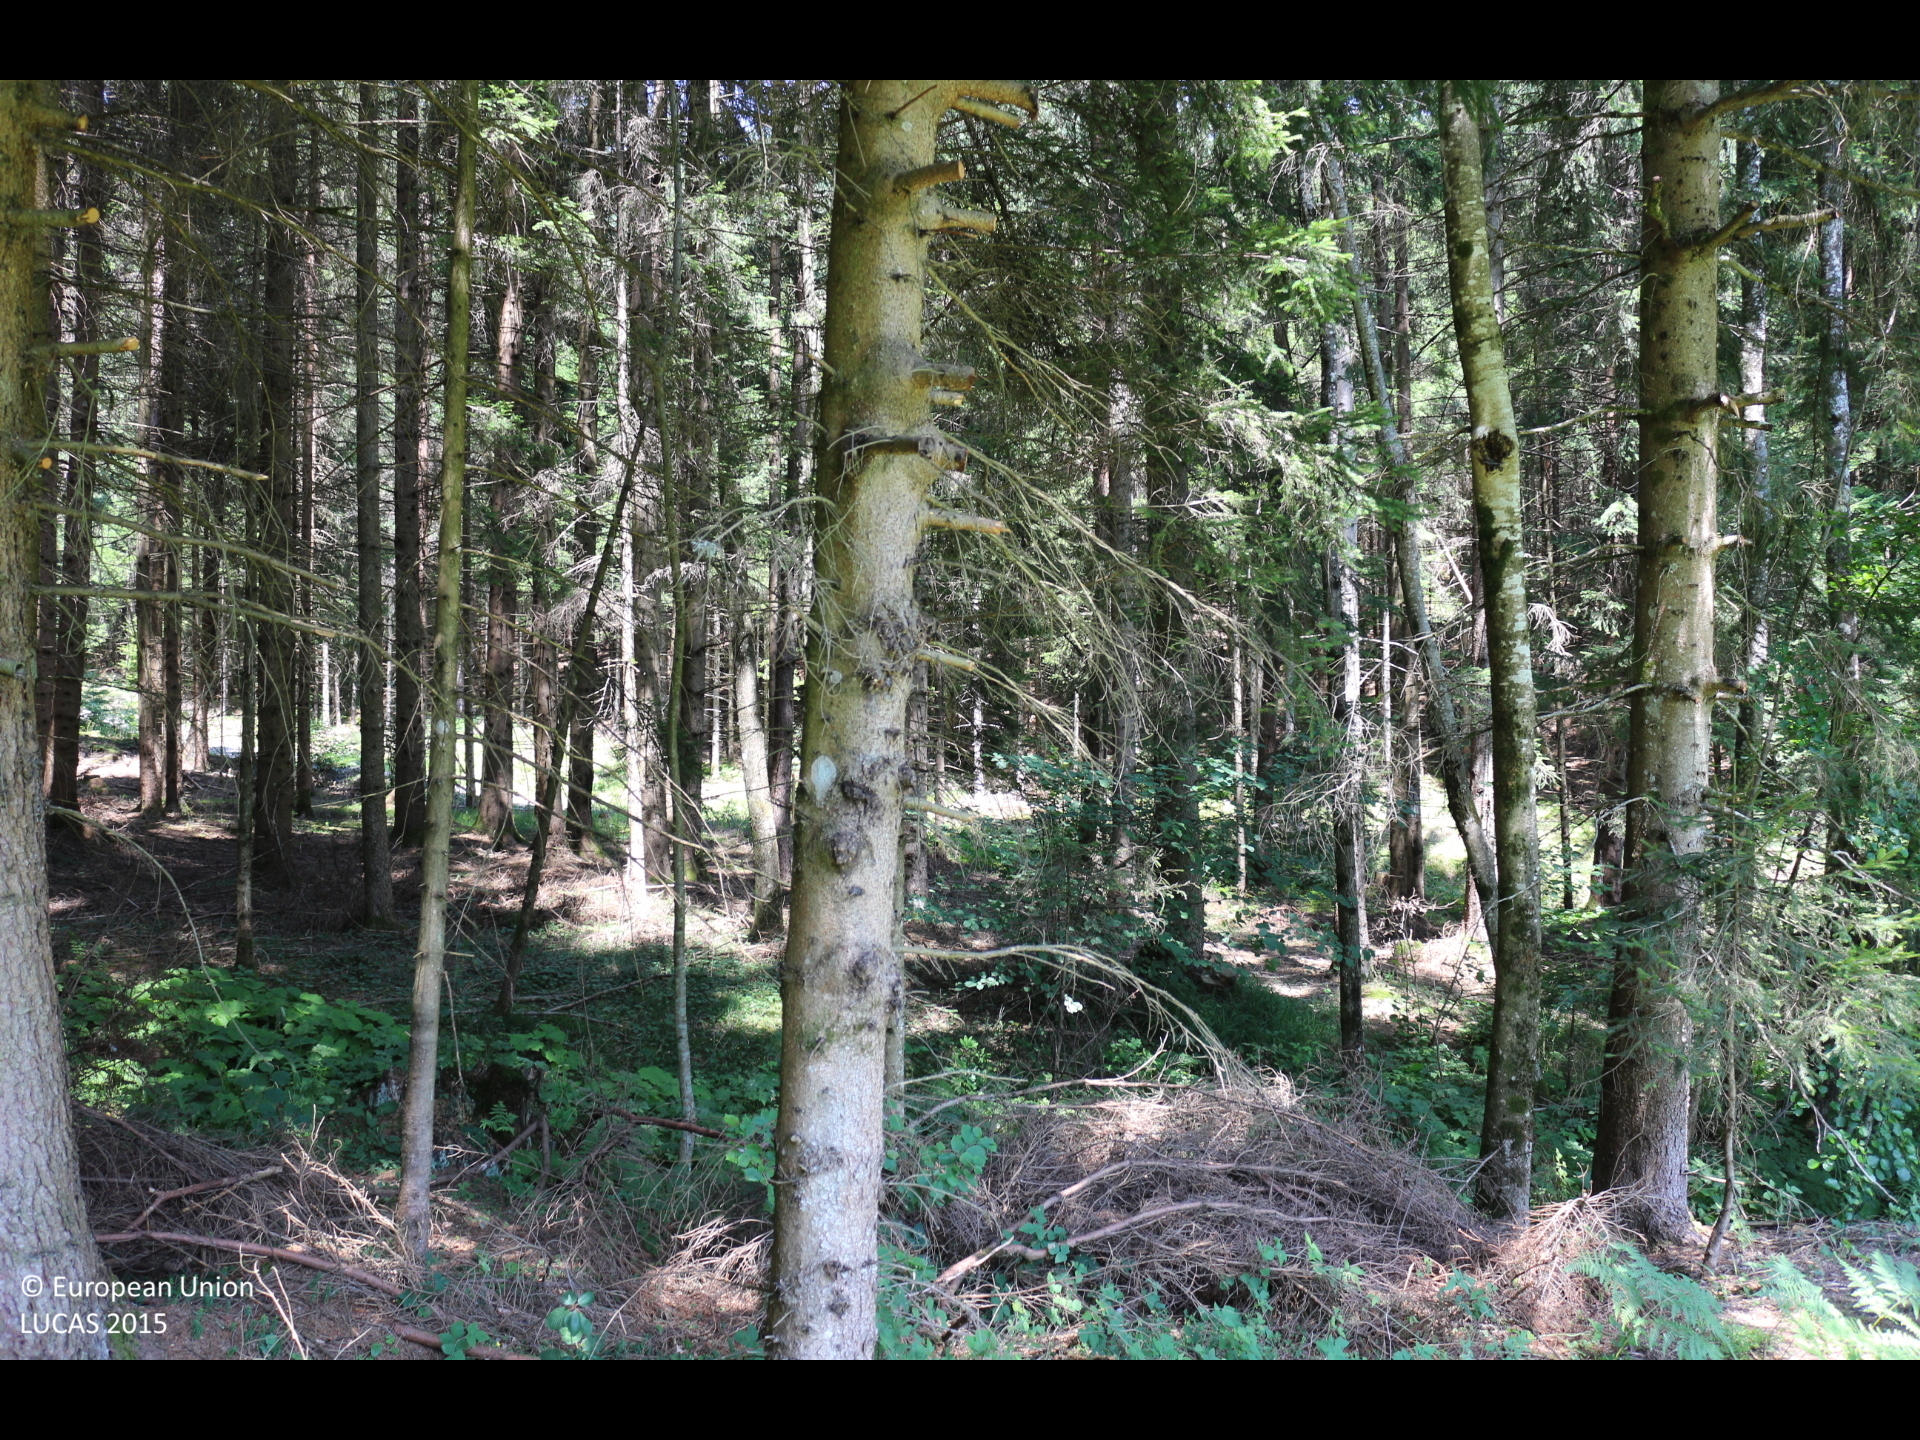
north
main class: Grassland
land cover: Grassland without tree/shrub cover
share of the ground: > 75 %
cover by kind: herbaceous plants 100 %
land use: Agriculture (excluding fallow land and kitchen gardens)
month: July
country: AT
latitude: 46.7423
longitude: 13.5705
